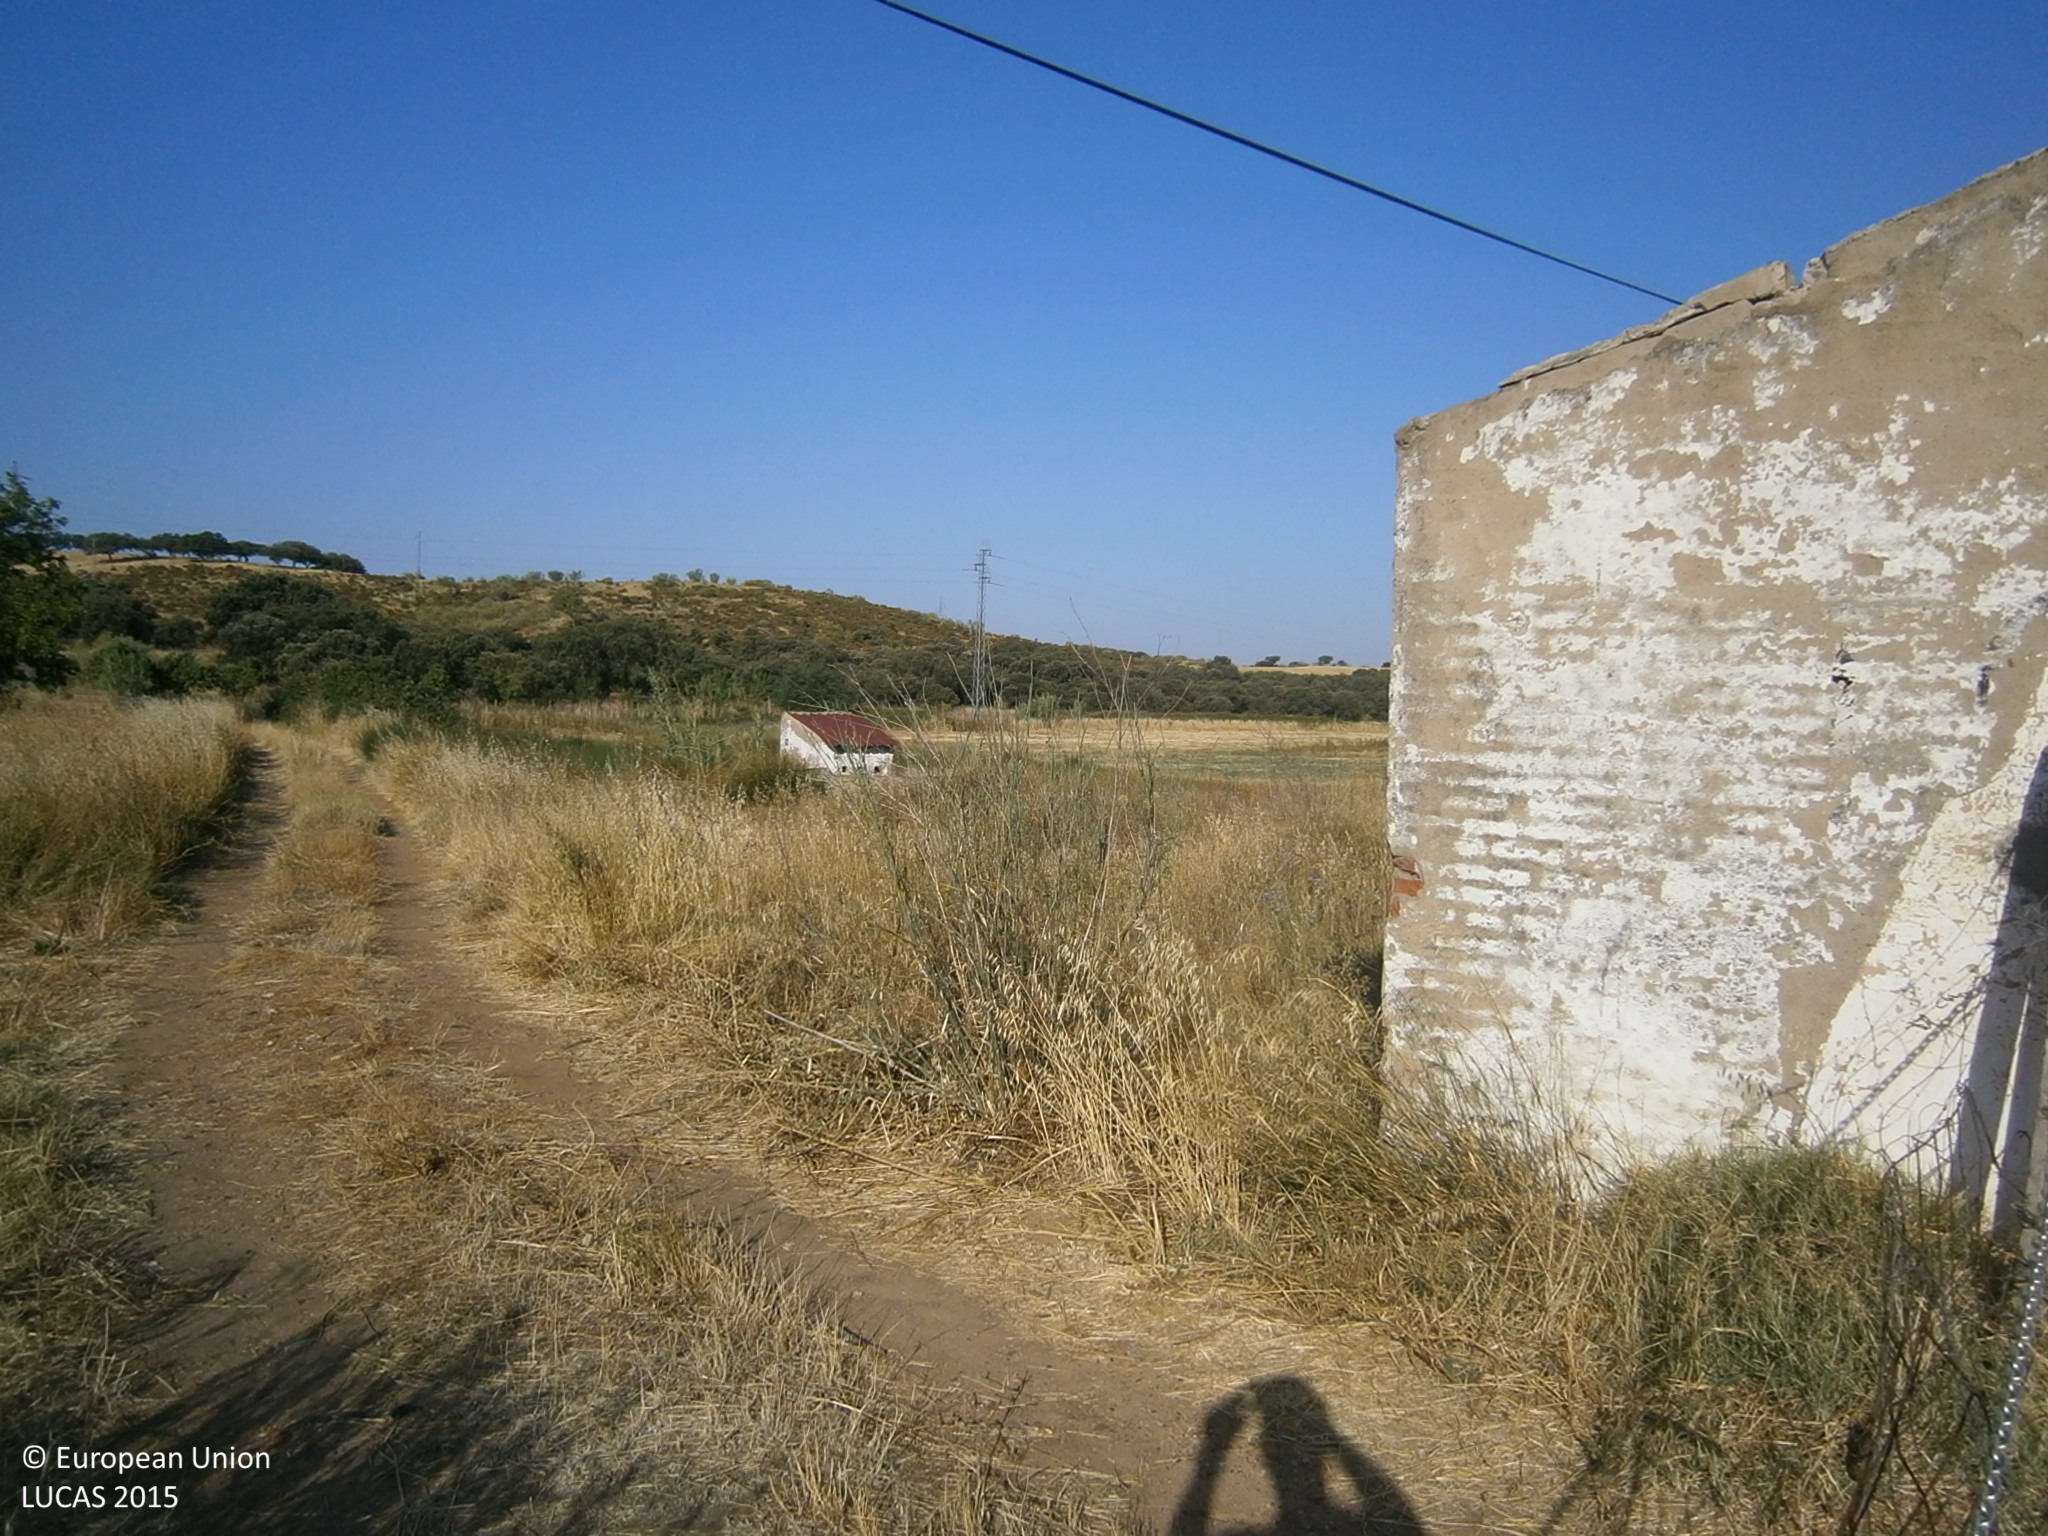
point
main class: Cropland
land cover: Oats
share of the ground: > 75 %
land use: Agriculture (excluding fallow land and kitchen gardens)
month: June
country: ES
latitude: 38.8092
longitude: -6.8915
